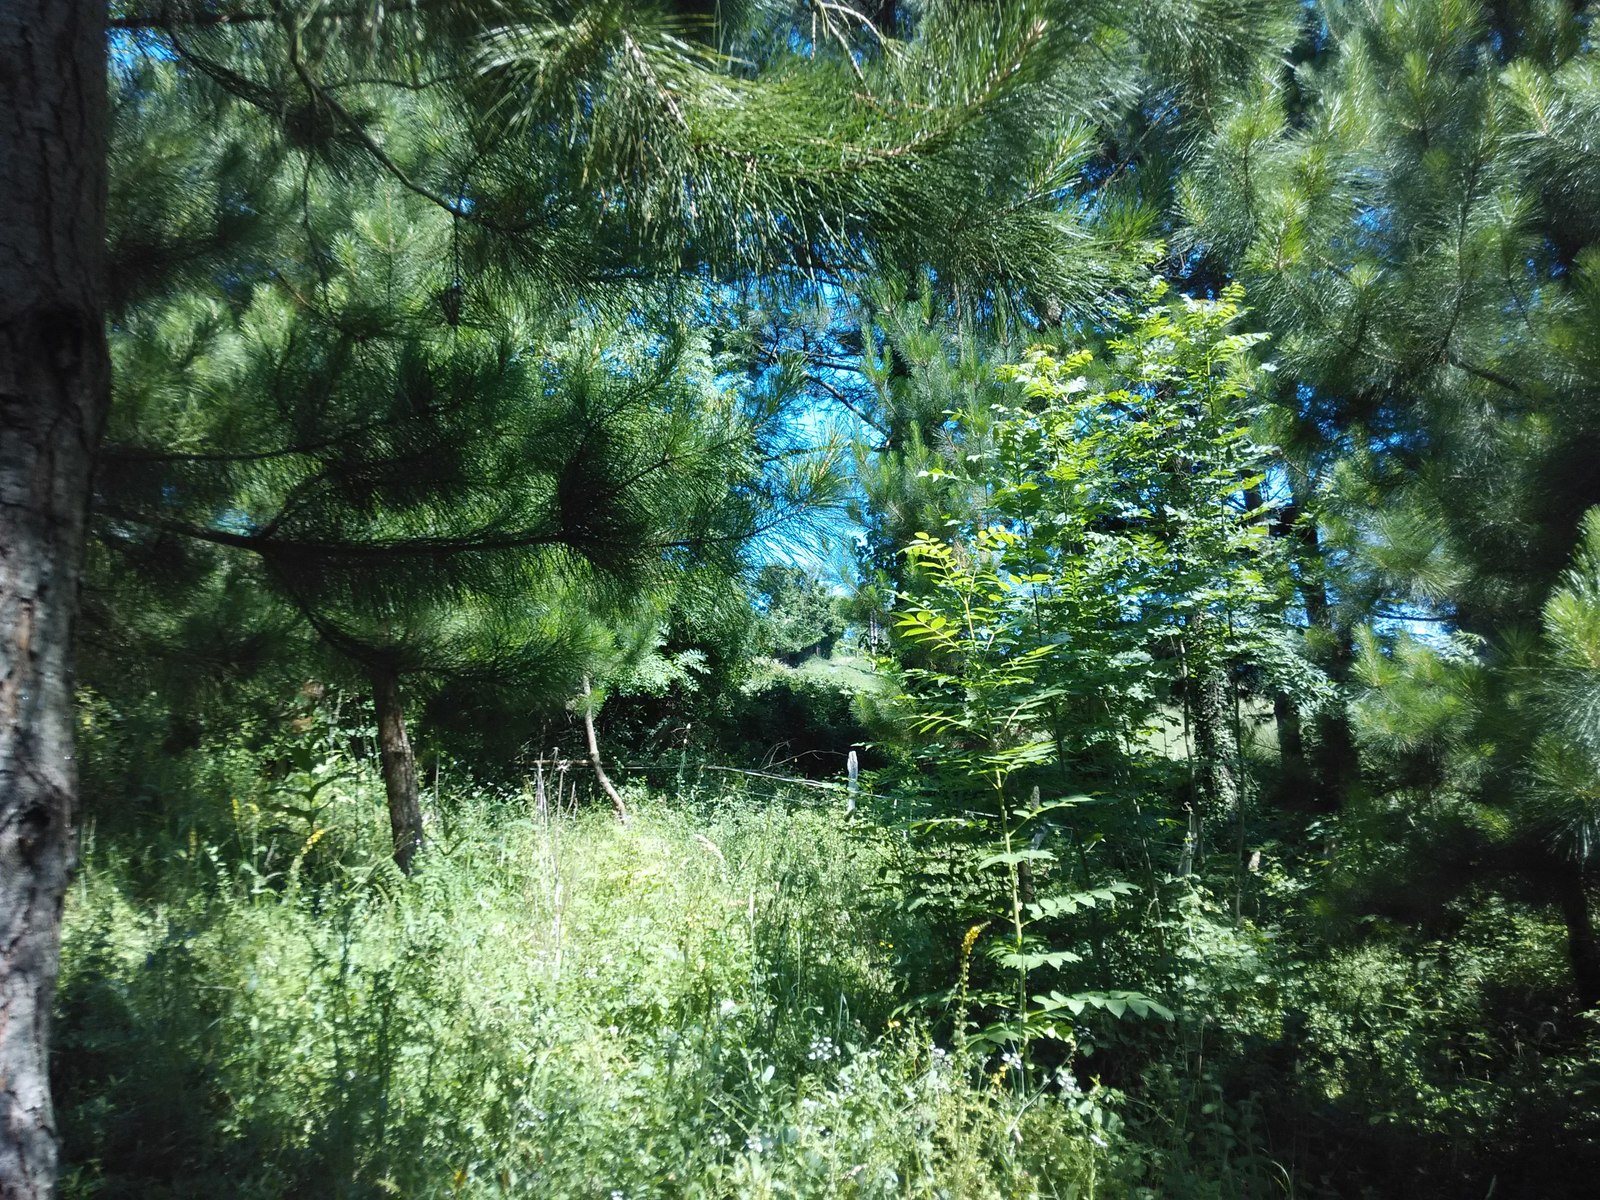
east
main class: Woodland
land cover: Pine dominated coniferous woodland
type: exotic forest
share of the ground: > 75 %
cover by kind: coniferous forest trees 80 %, herbaceous plants 15 %, shrubs 5 %
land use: Forestry
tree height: < 5 m
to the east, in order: Pine dominated coniferous woodland; Fences; Grassland without tree/shrub cover; Fences; Artificial constructions in urban areas; Electric lines; Paved roads, cycling and walking lanes; Fences; Grassland without tree/shrub cover; Apple fruit; Abandoned hedges; Electric lines; Nuts trees; Fences; Other bare soil; Shrubland with sparse tree cover; Grassland without tree/shrub cover
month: June
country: ES
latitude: 43.0430
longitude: -2.5105
